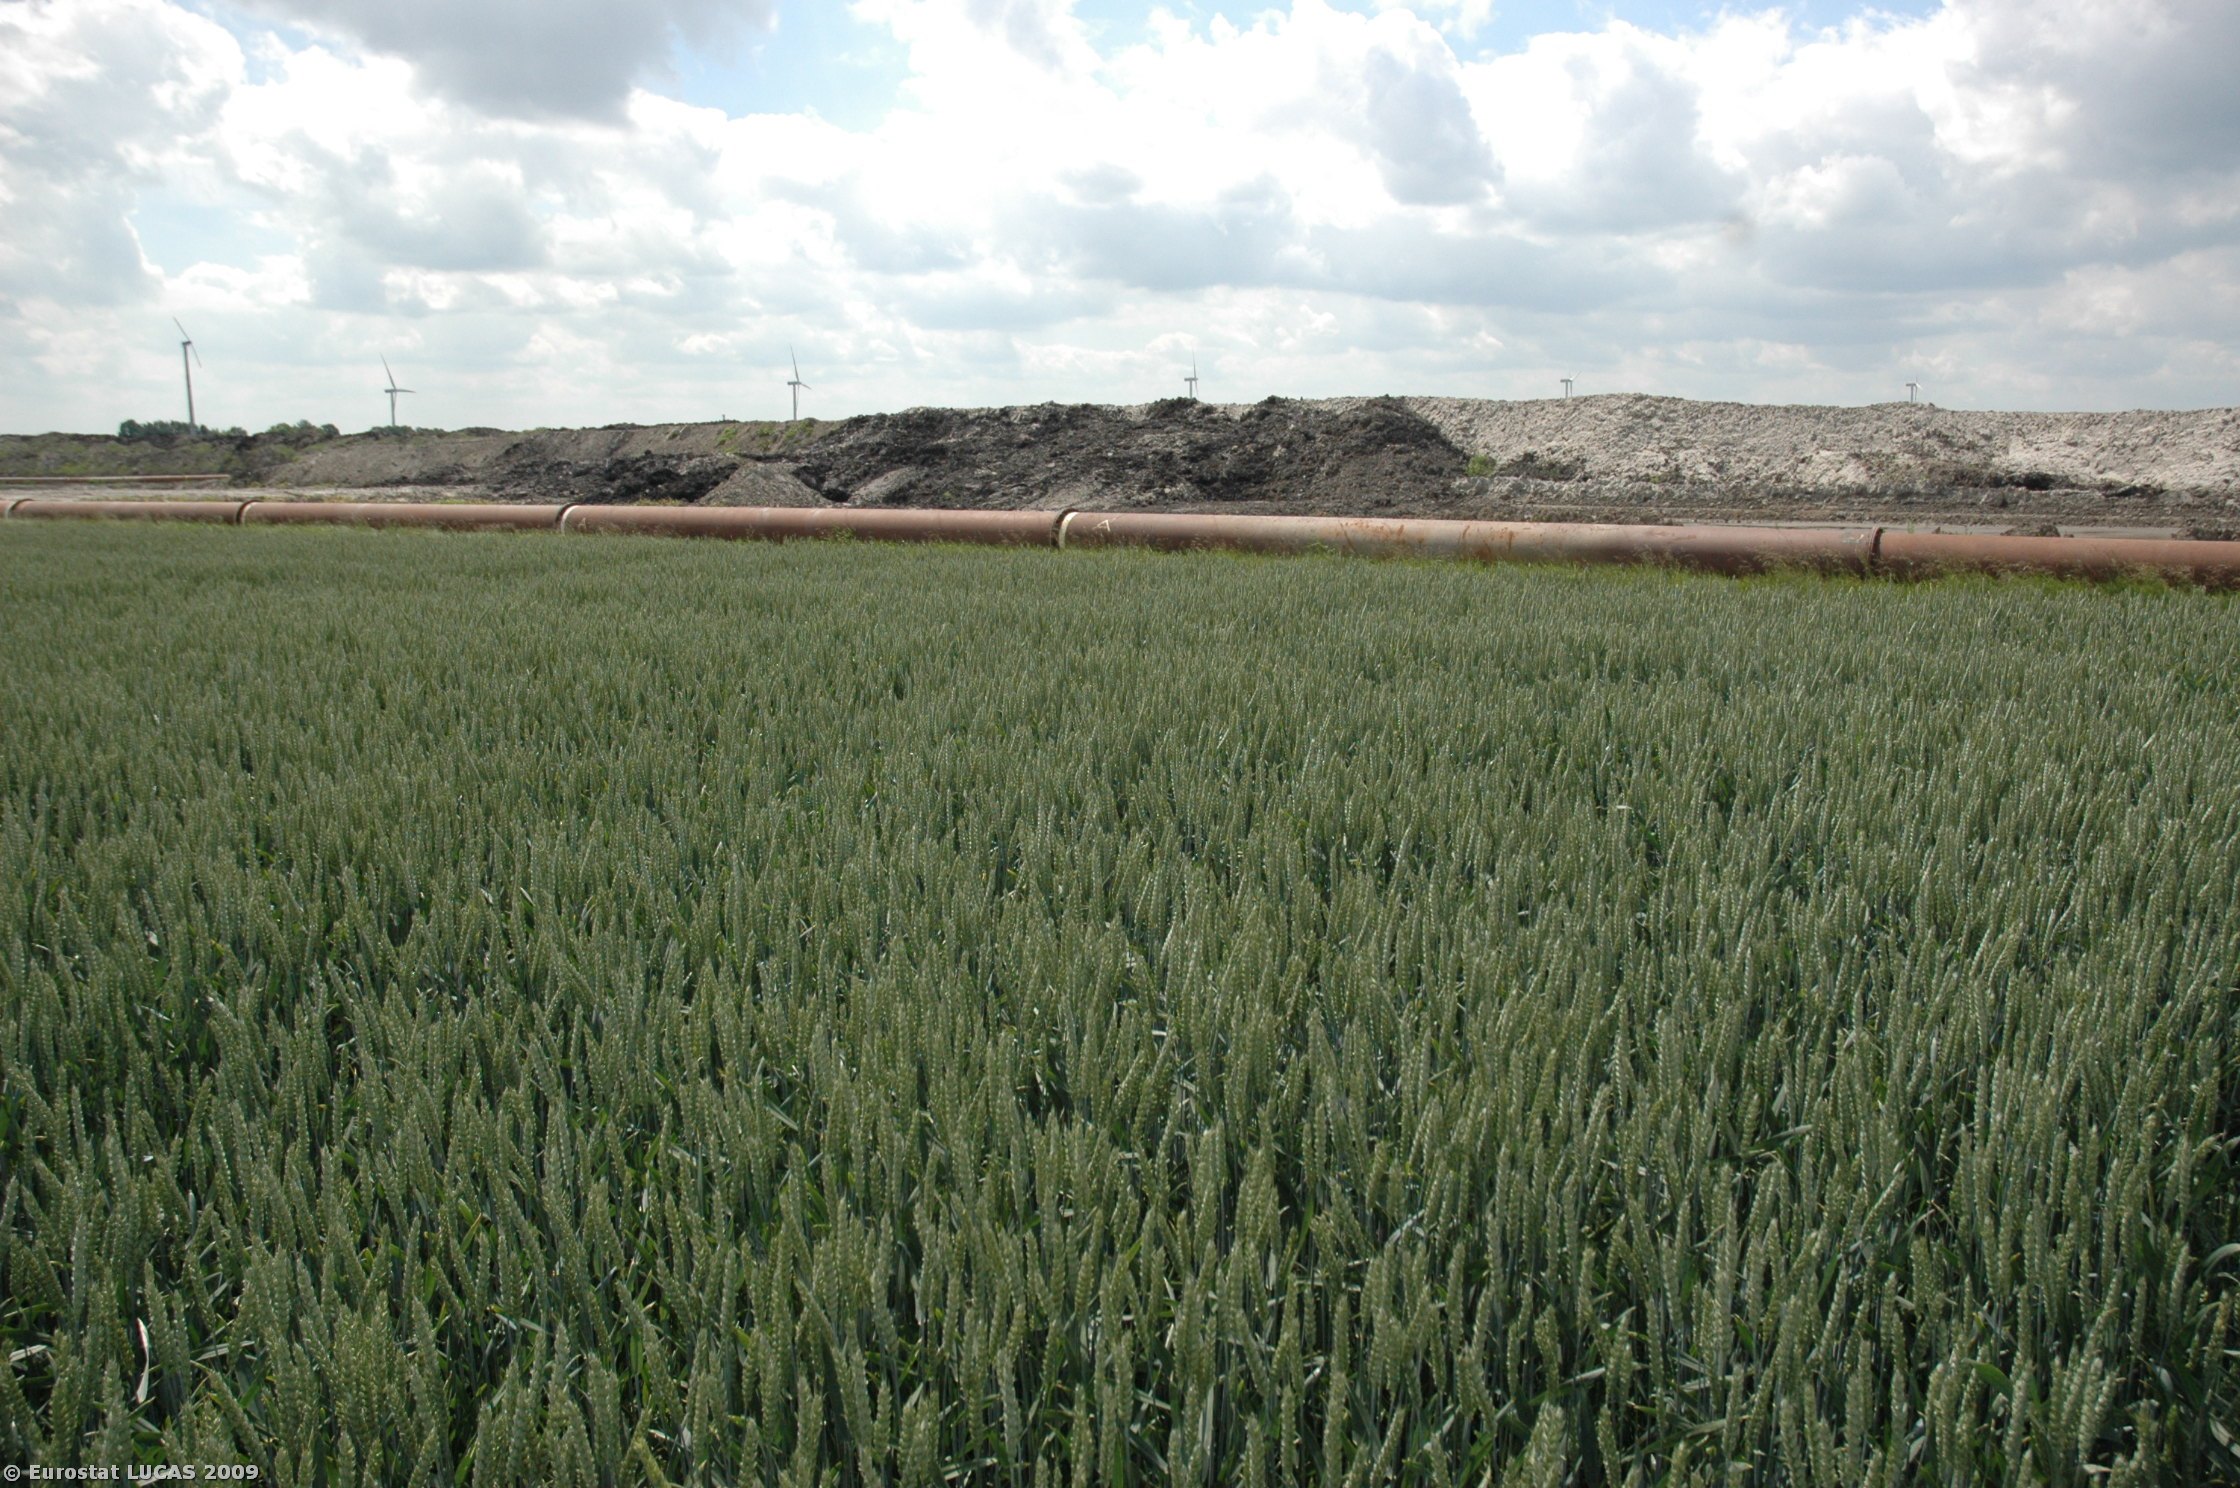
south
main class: Cropland
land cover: Common wheat
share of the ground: > 75 %
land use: Agriculture (excluding fallow land and kitchen gardens)
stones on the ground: < 10 %
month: June
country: NL
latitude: 52.5498
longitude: 5.6482
